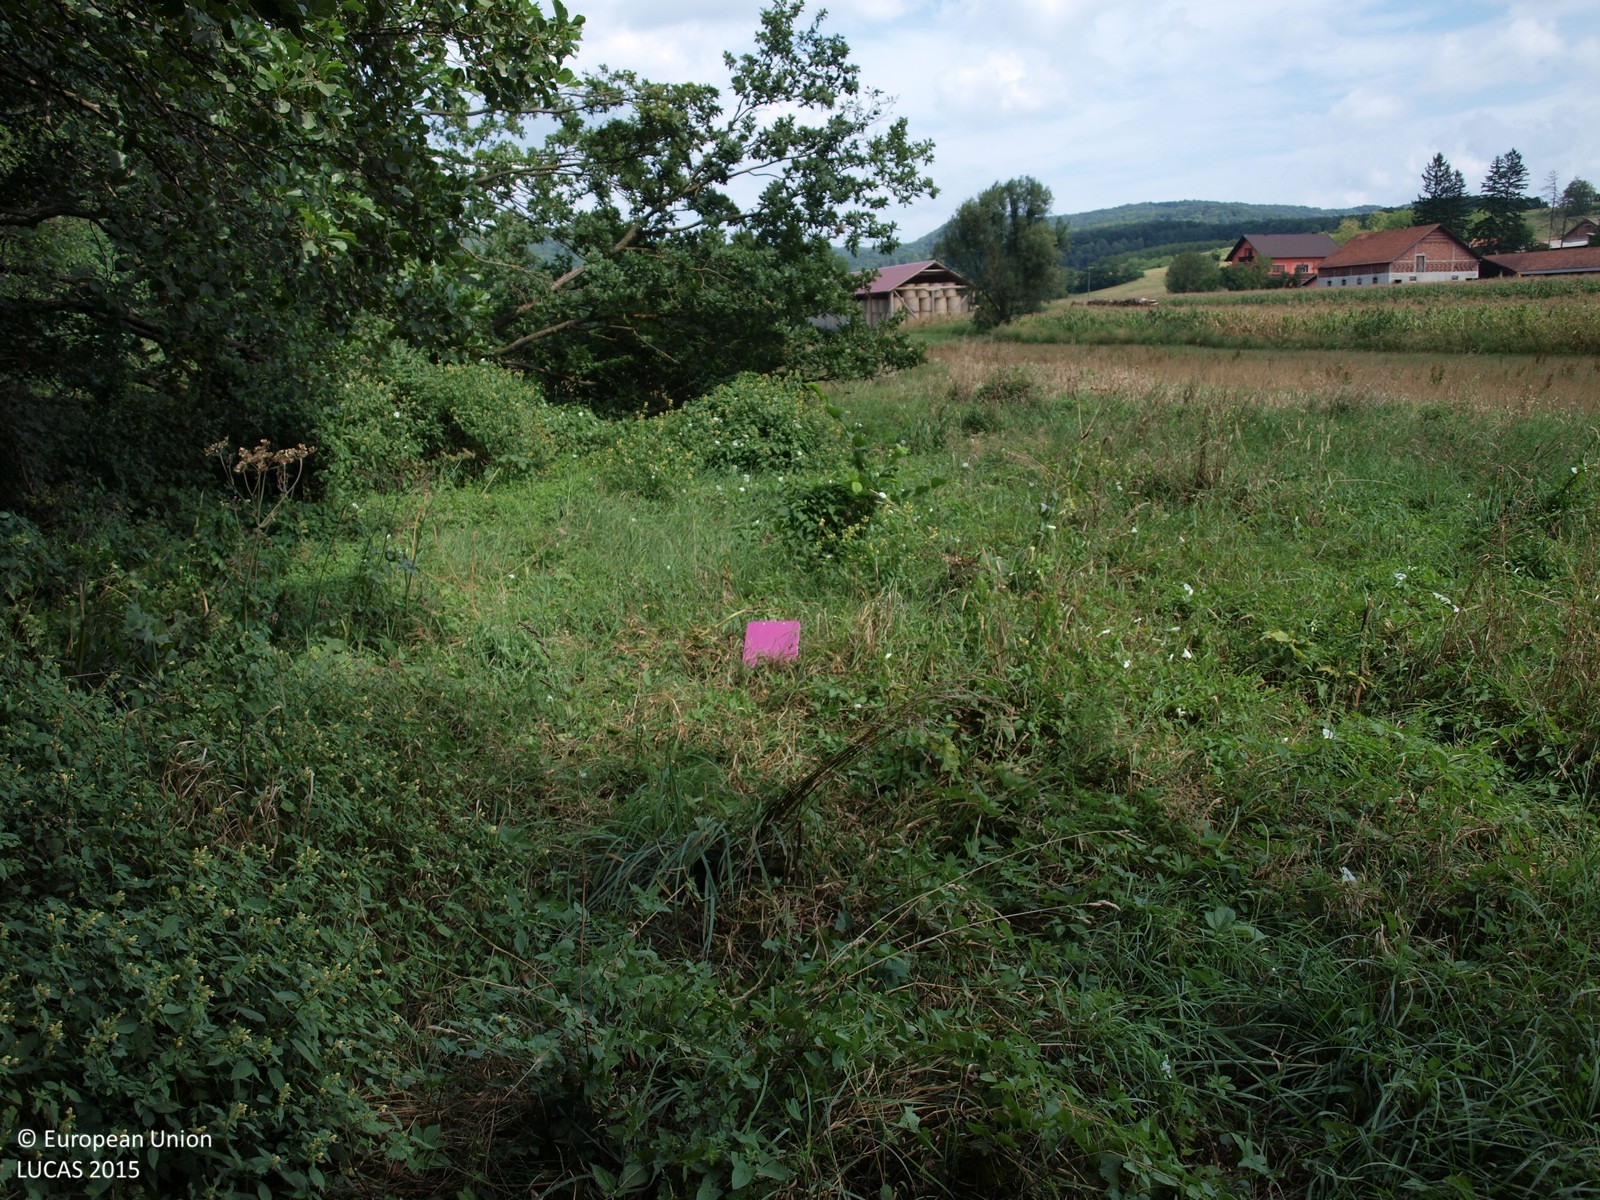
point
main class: Grassland
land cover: Grassland without tree/shrub cover
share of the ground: > 75 %
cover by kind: herbaceous plants 100 %
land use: Agriculture (excluding fallow land and kitchen gardens)
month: August
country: HR
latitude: 46.1168
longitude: 16.5087
